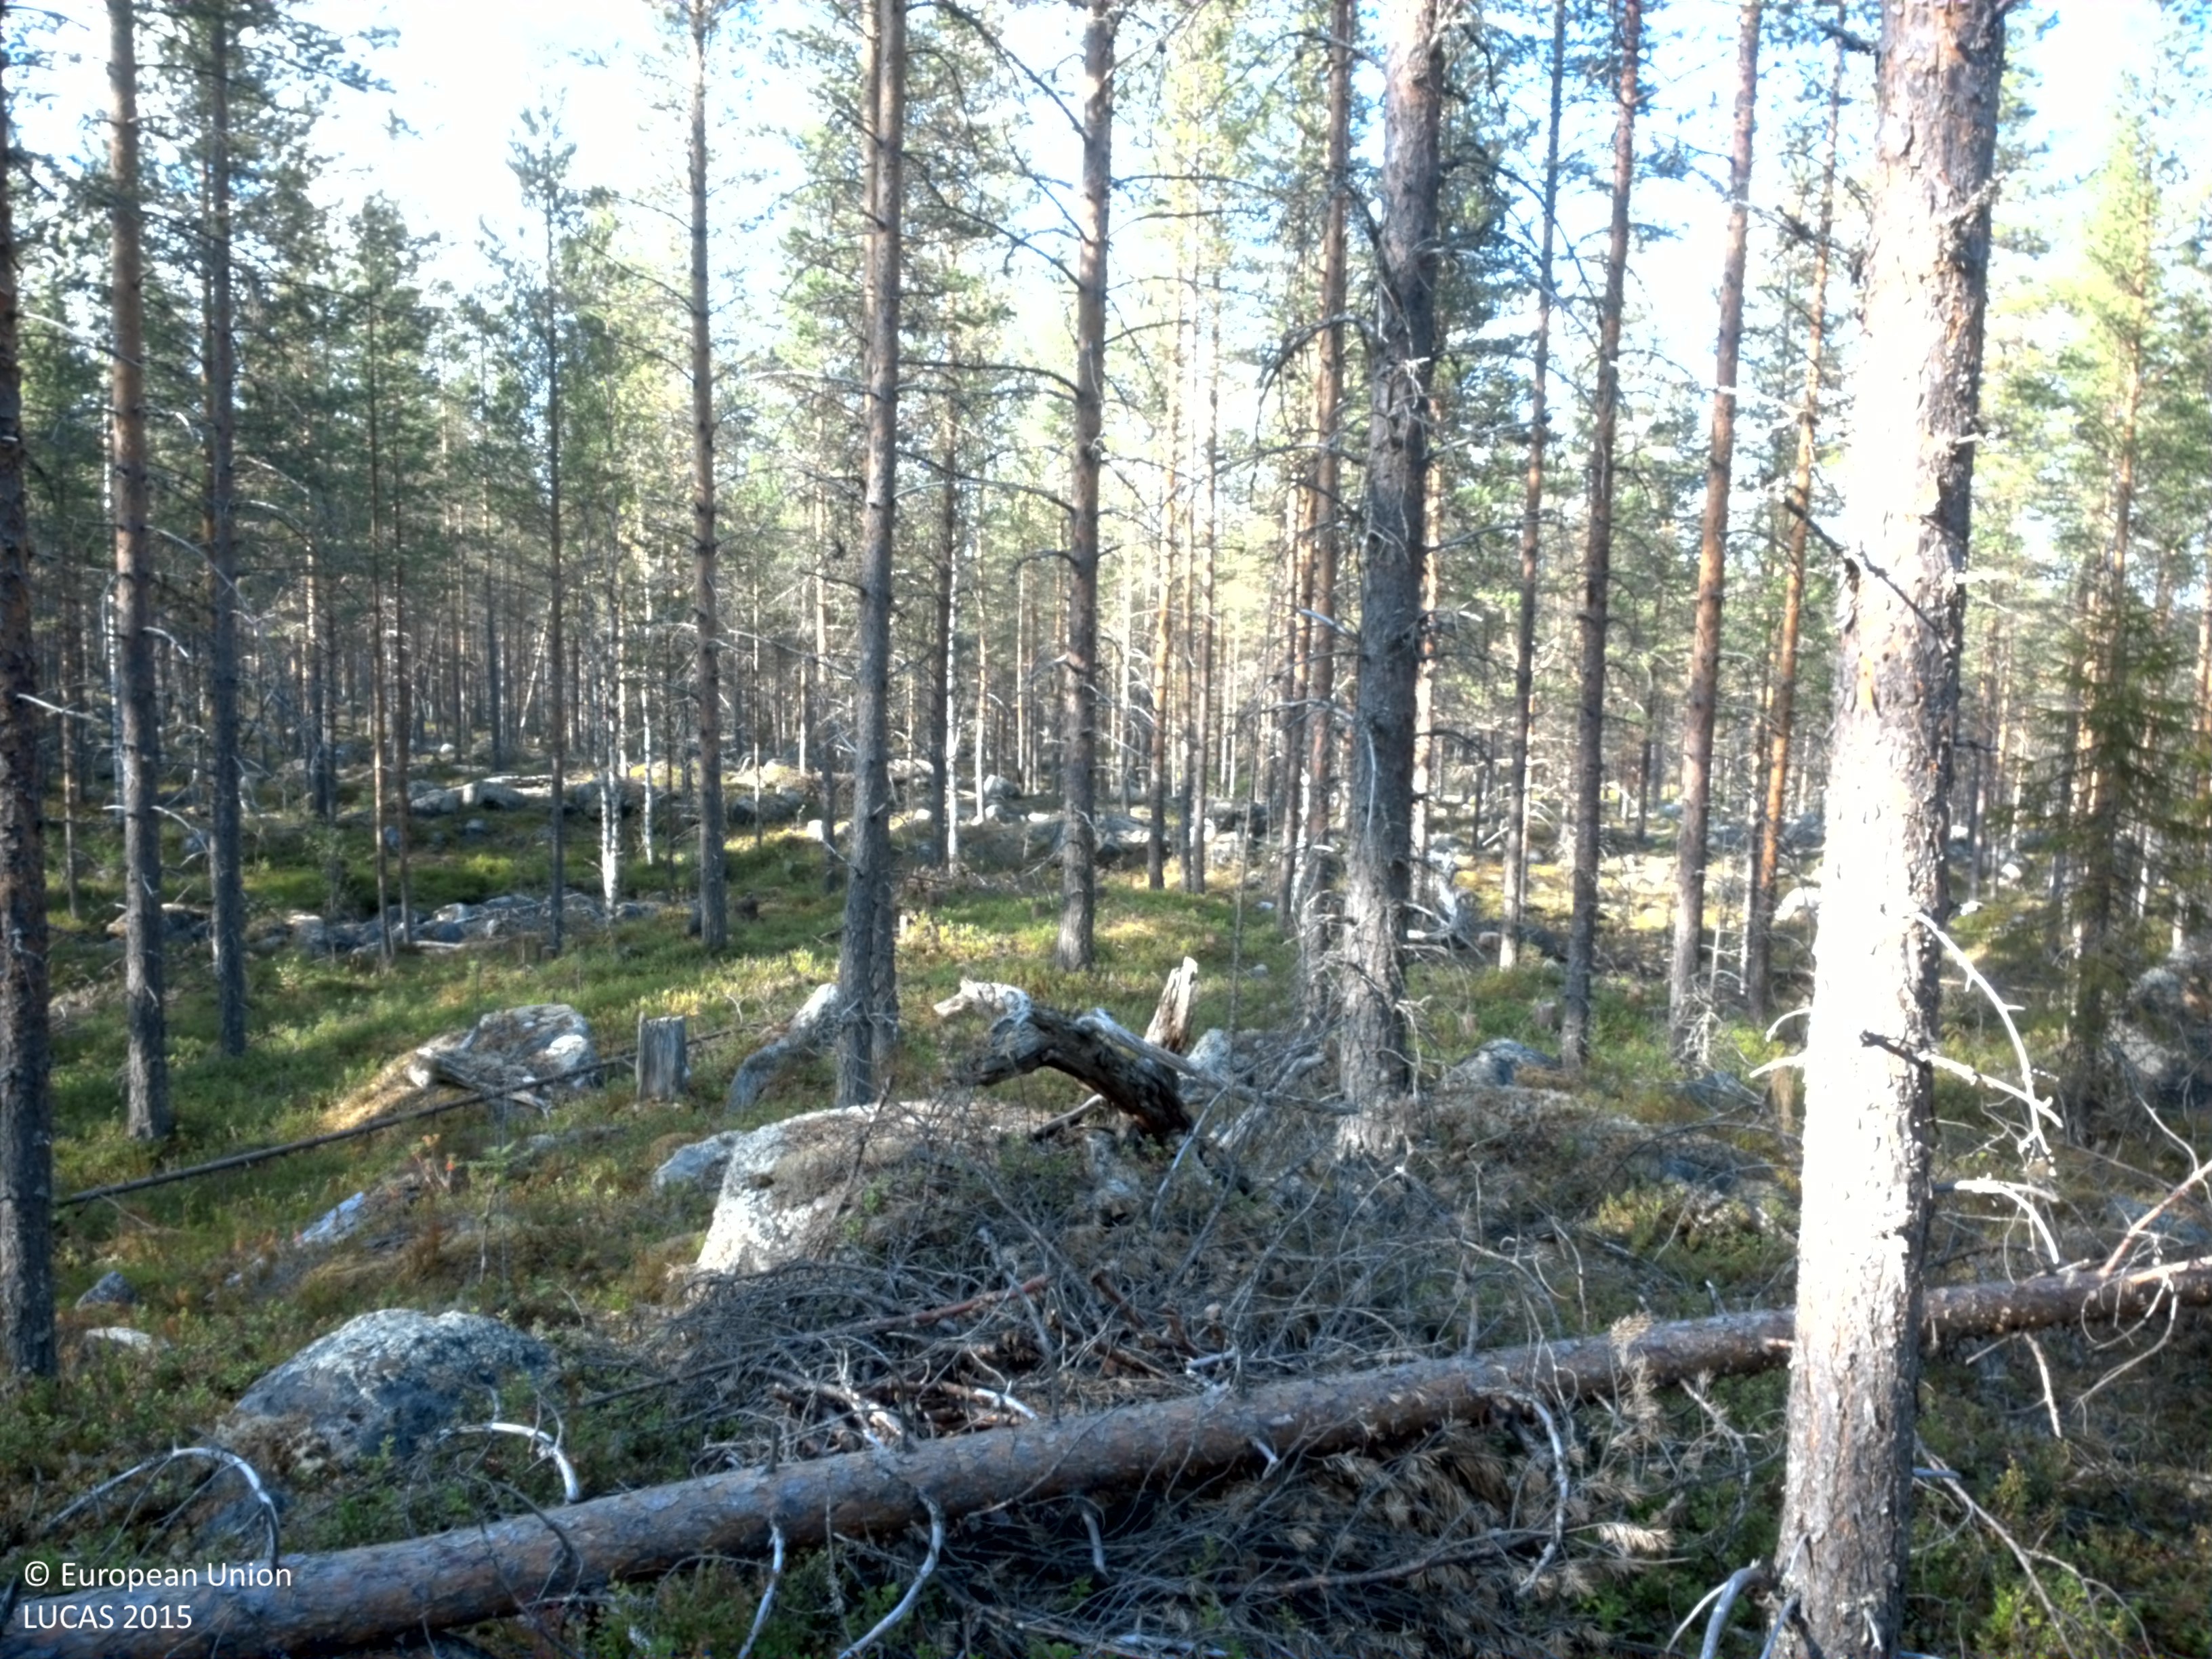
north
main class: Woodland
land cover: Pine dominated coniferous woodland
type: boreal forest
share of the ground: 50 - 75 %
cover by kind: coniferous forest trees 55 %, shrubs 35 %, lichens and mosses 10 %
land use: Forestry
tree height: > 5 m
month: August
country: SE
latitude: 64.5653
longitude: 18.9214
